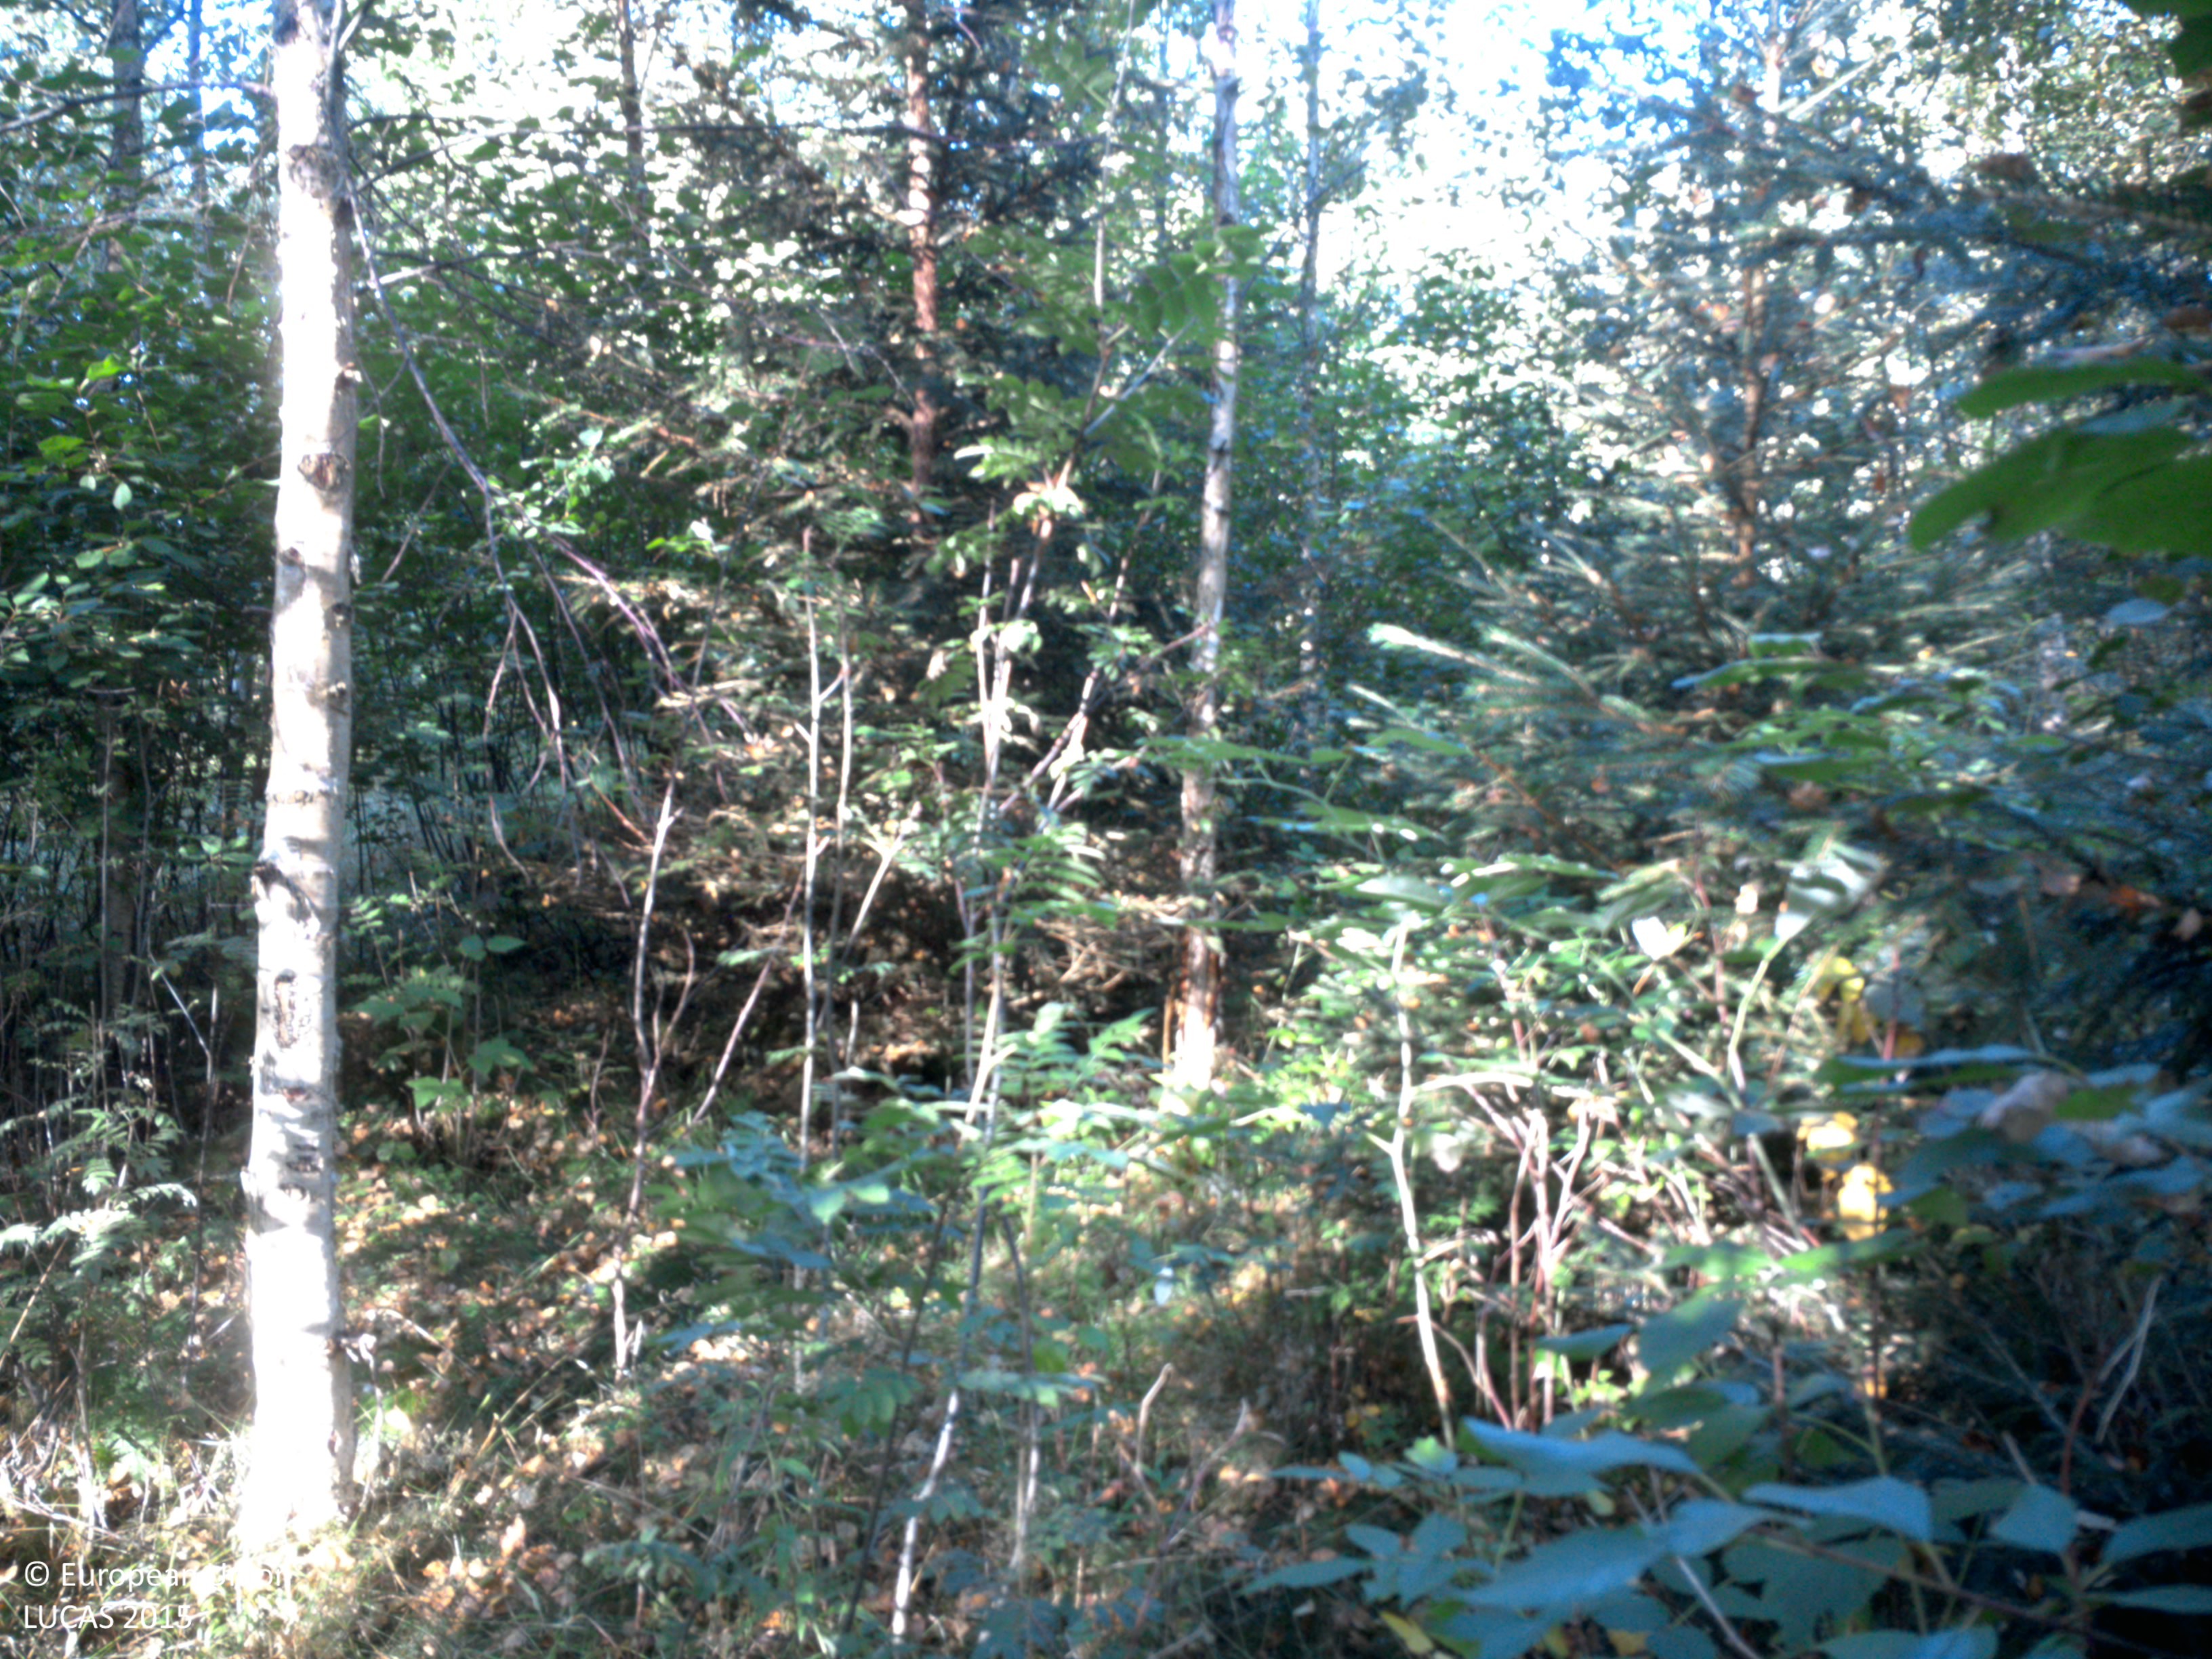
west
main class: Woodland
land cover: Broadleaved woodland
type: hemiboreal forest and nemoral coniferous forest and mixed broadleaved-coniferous forest
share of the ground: > 75 %
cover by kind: broadleaved forest trees 75 %, herbaceous plants 20 %, lichens and mosses 5 %
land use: Forestry
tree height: > 5 m
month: August
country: SE
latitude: 58.5774
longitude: 12.3168
